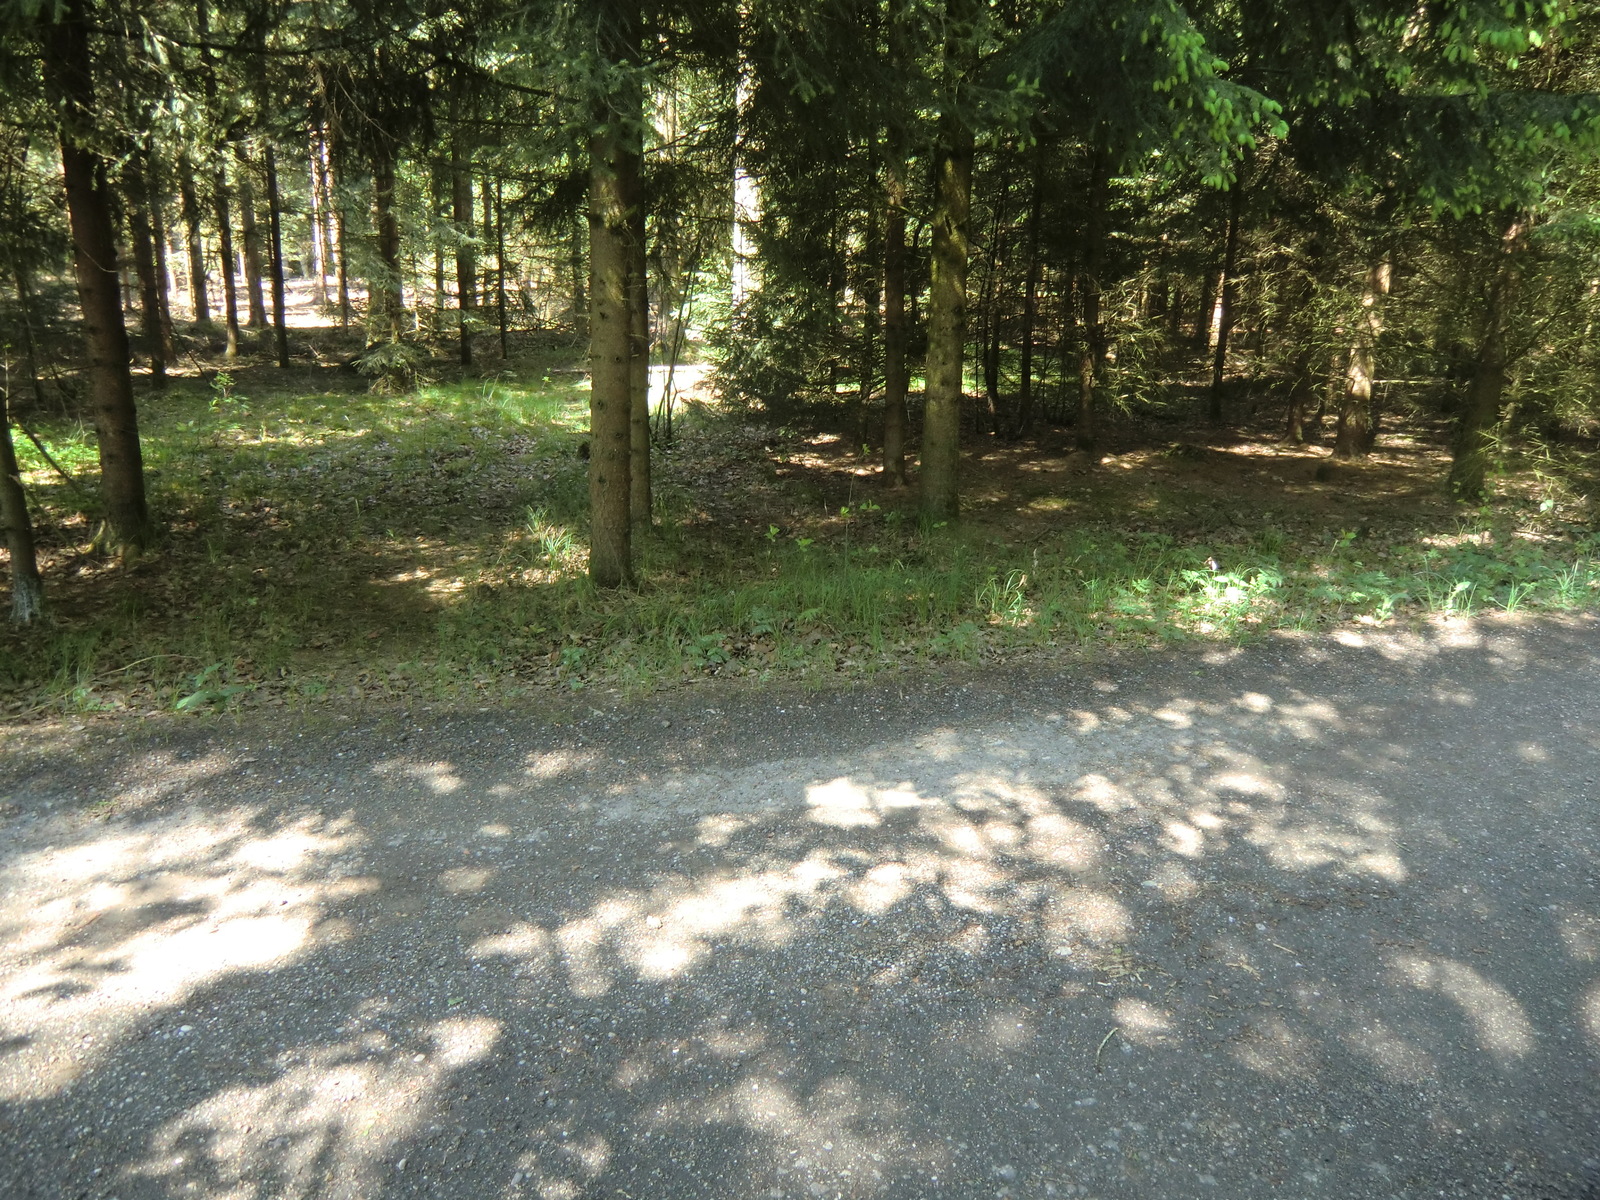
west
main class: Woodland
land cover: Pine dominated mixed woodland
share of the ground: > 75 %
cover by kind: coniferous forest trees 40 %, broadleaved forest trees 40 %, shrubs 5 %, herbaceous plants 5 %, lichens and mosses 5 %, consolidated bare surface 5 %
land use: Forestry
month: May
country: AT
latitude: 48.3145
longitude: 14.4368
